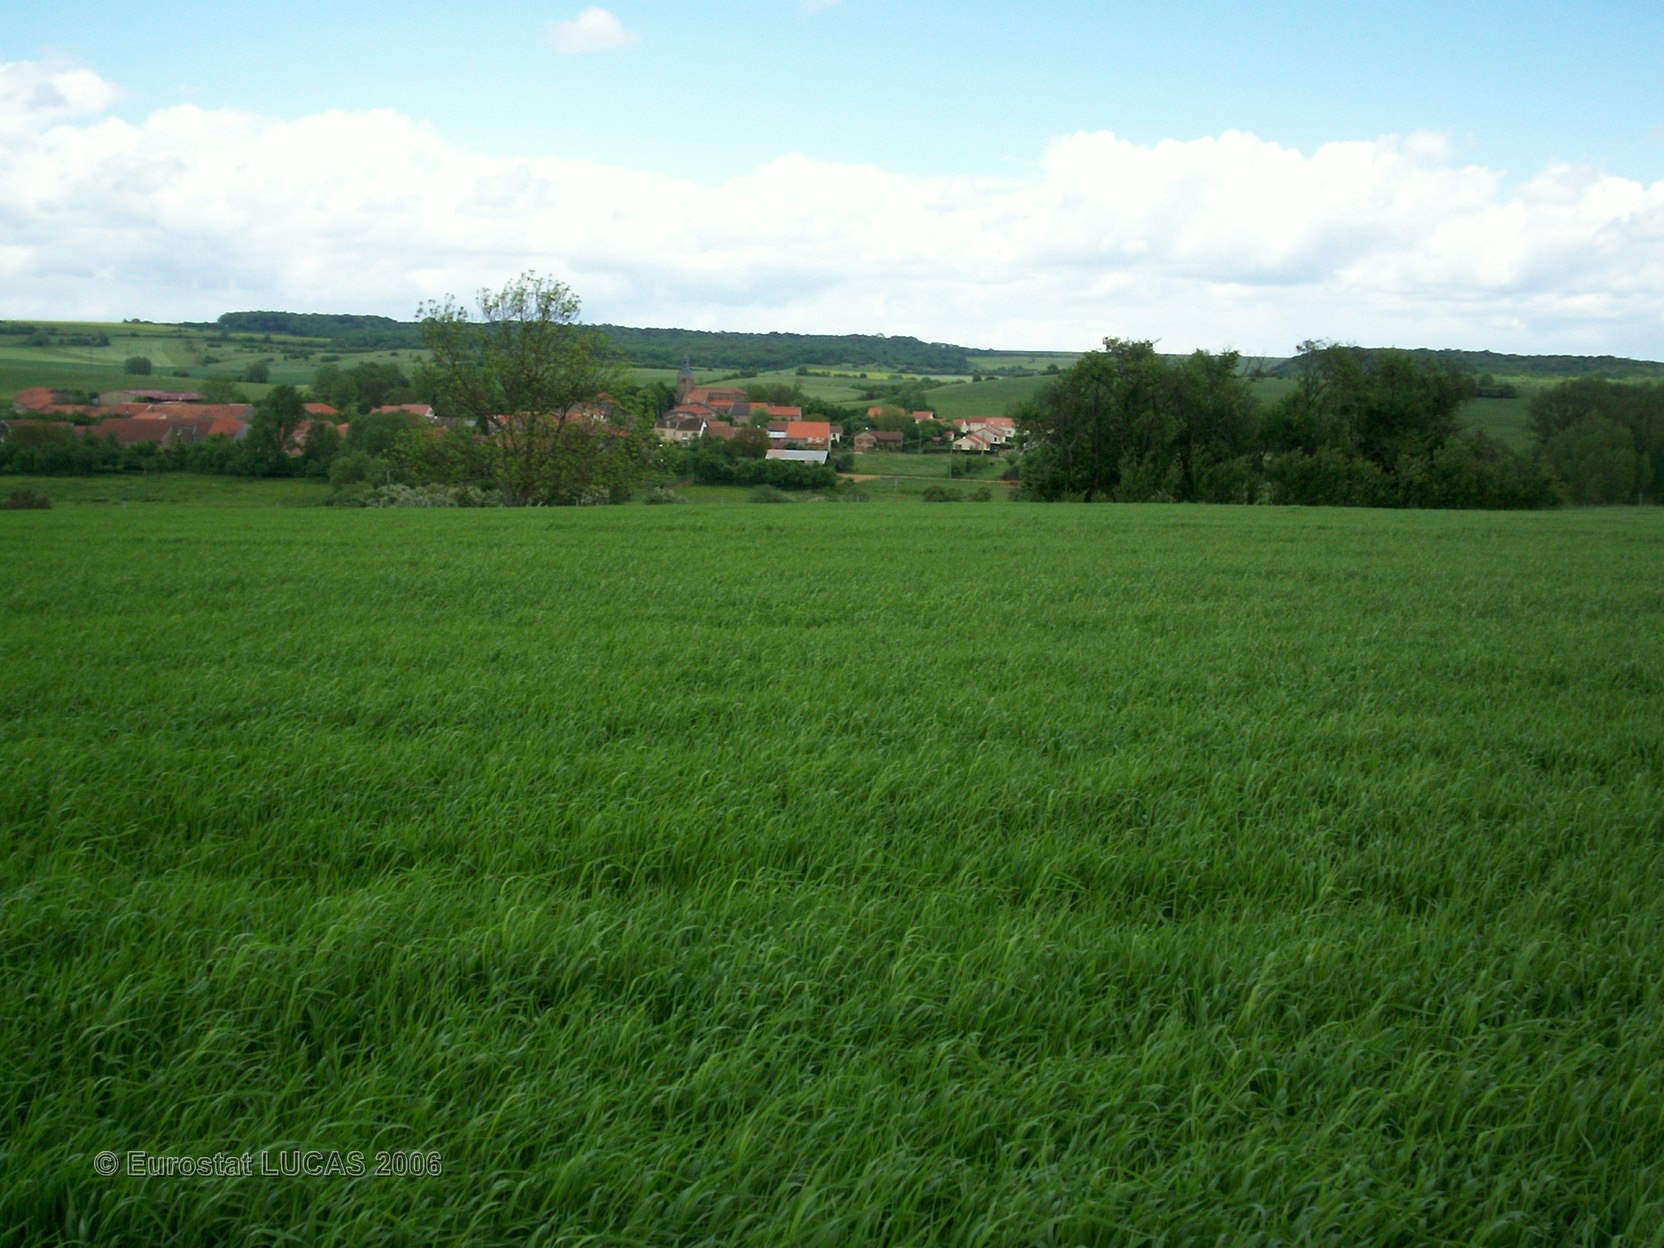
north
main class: Cropland
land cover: Barley
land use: Agriculture (excluding fallow land and kitchen gardens)
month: May
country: FR
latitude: 49.2987
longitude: 5.8600
